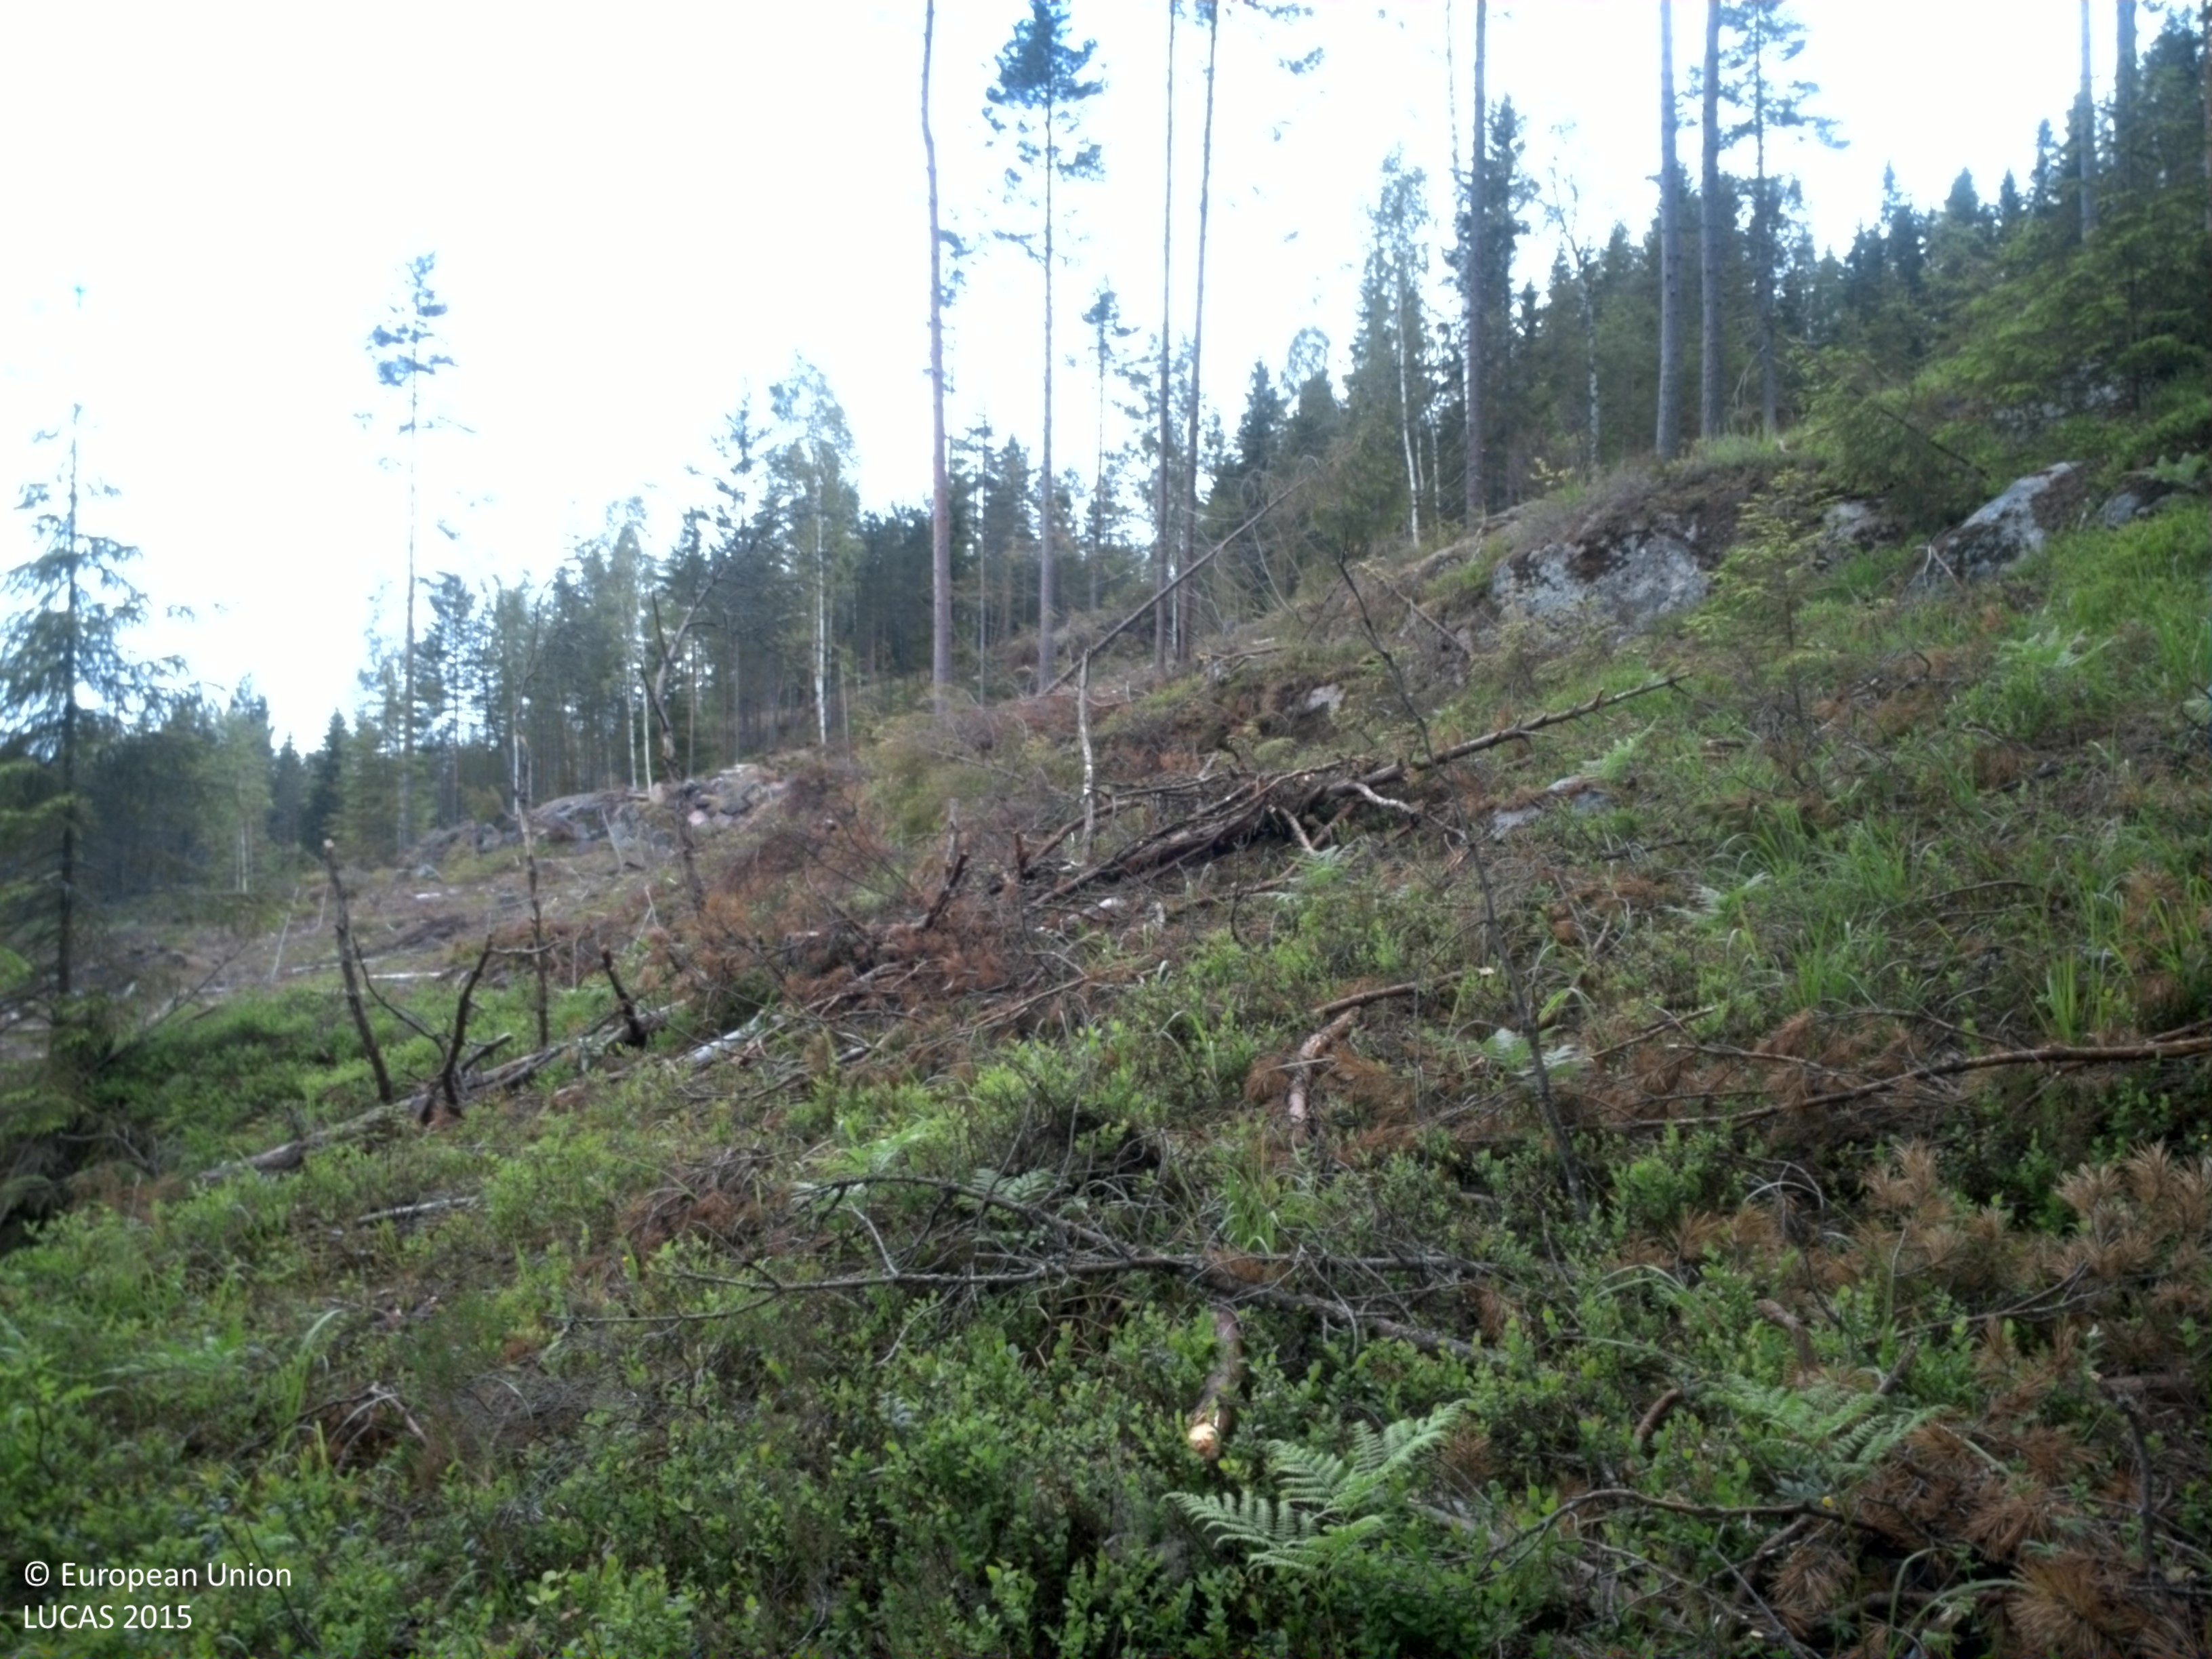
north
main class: Shrubland
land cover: Shrubland with sparse tree cover
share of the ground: 50 - 75 %
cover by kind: shrubs 70 %, lichens and mosses 10 %, consolidated bare surface 10 %, coniferous forest trees 5 %, herbaceous plants 5 %
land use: Forestry
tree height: < 5 m
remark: Clear cut
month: June
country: SE
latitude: 59.7512
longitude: 12.0764
